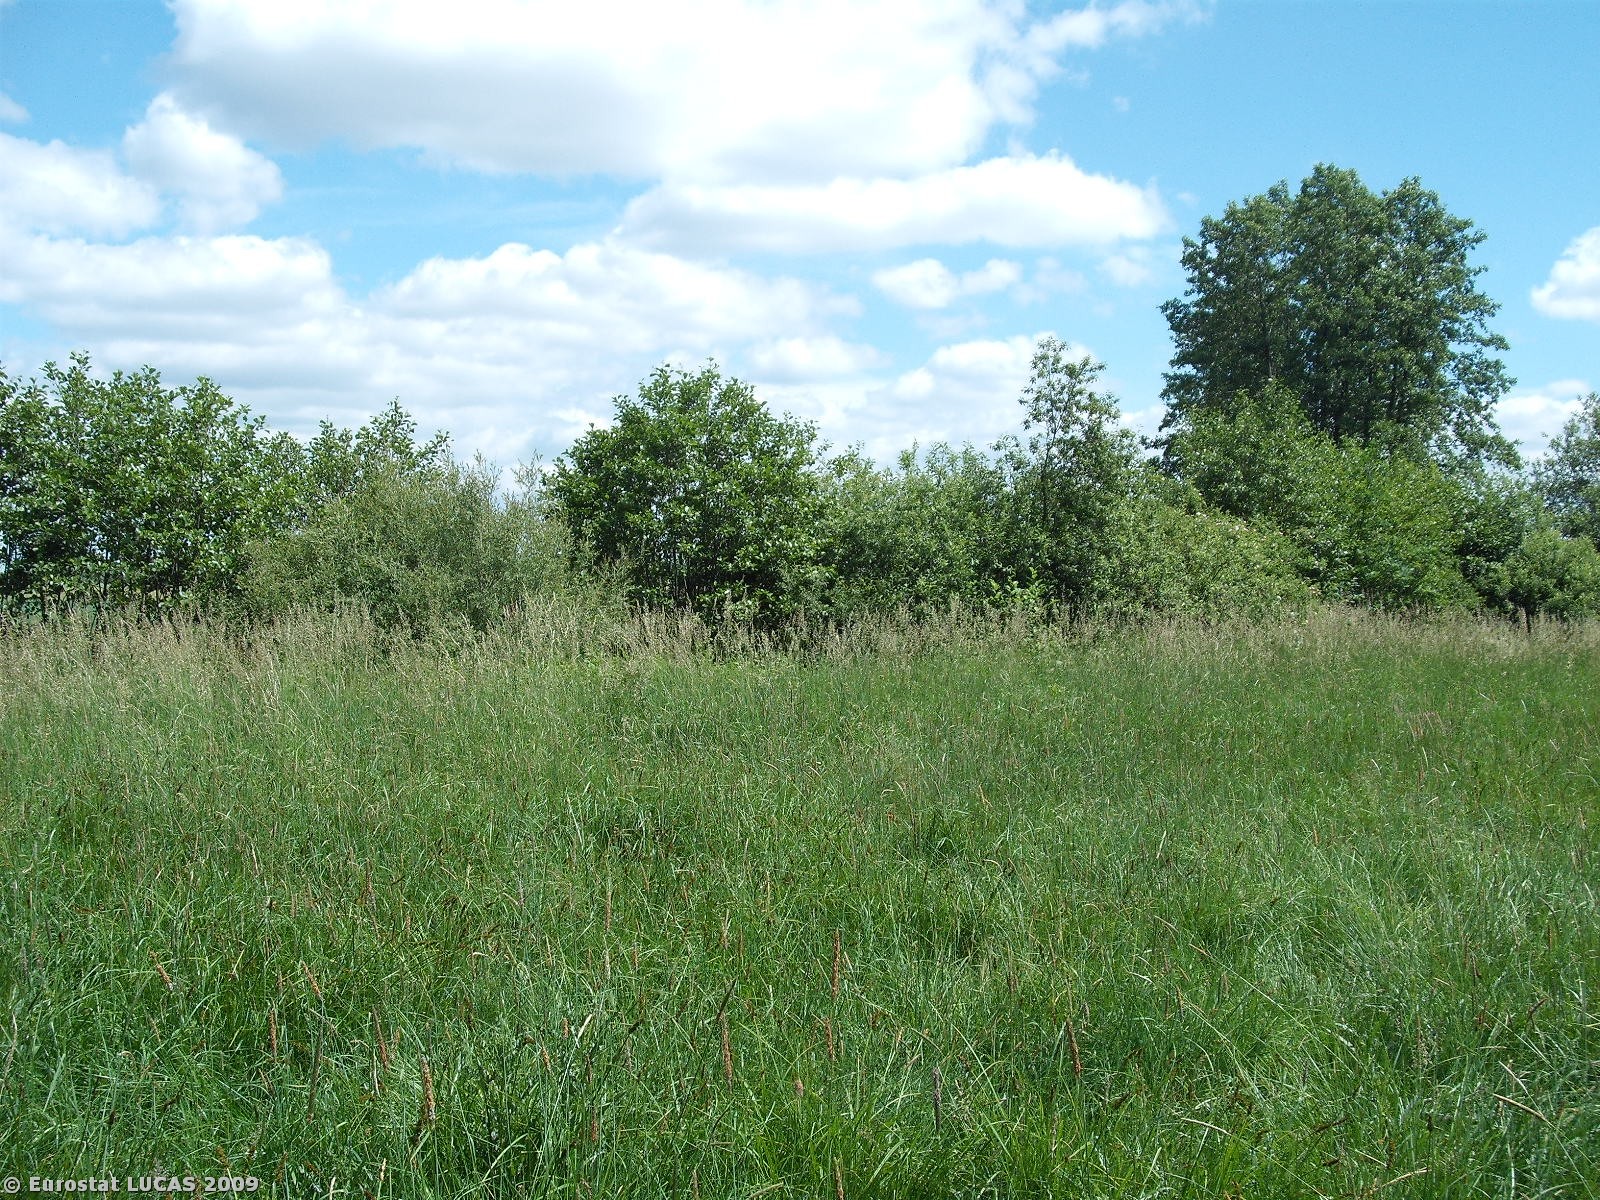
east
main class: Grassland
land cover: Grassland with sparse tree/shrub cover
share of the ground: > 75 %
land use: Unused
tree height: < 5 m
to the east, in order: Grassland with sparse tree/shrub cover; Shrubland with sparse tree cover; Ditches and canals; Grassland without tree/shrub cover; Potatoes; Grass margins; Oats; Triticale; Other cereals; Oats
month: June
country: PL
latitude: 51.3562
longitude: 21.0014
